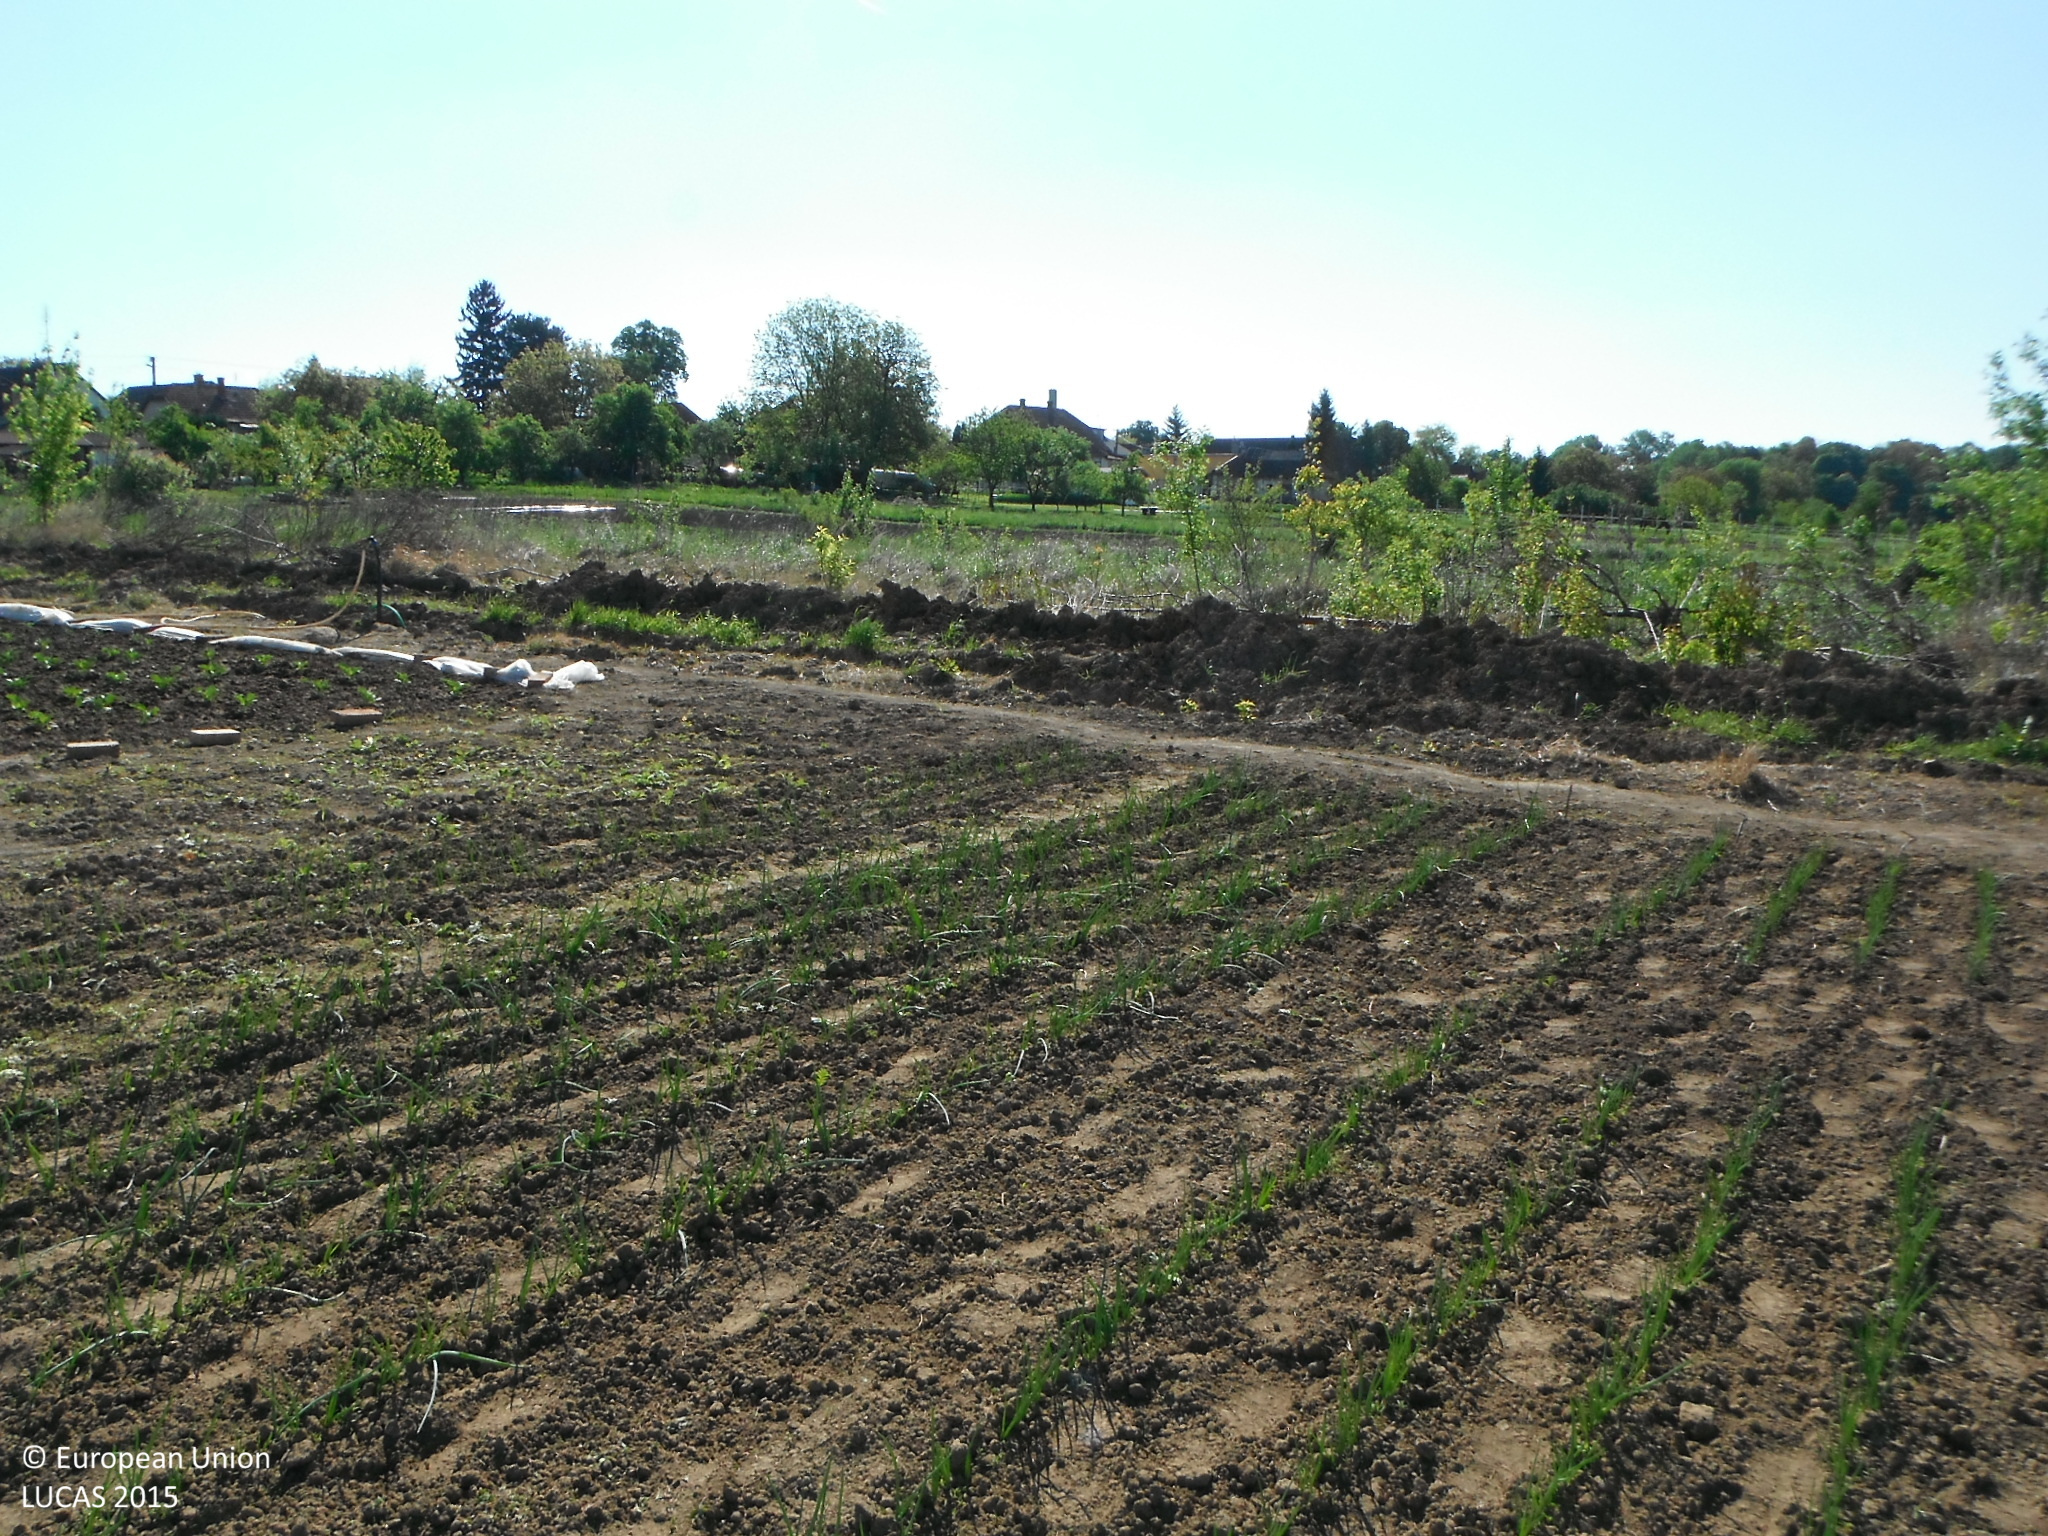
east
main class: Cropland
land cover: Other root crops
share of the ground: 10 - 25 %
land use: Kitchen garden
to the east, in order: Other root crops; Grassland with sparse tree/shrub cover; Other non-permanent industrial crops; Grassland without tree/shrub cover; Artificial constructions in urban areas
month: May
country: SK
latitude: 48.3453
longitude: 18.2860
